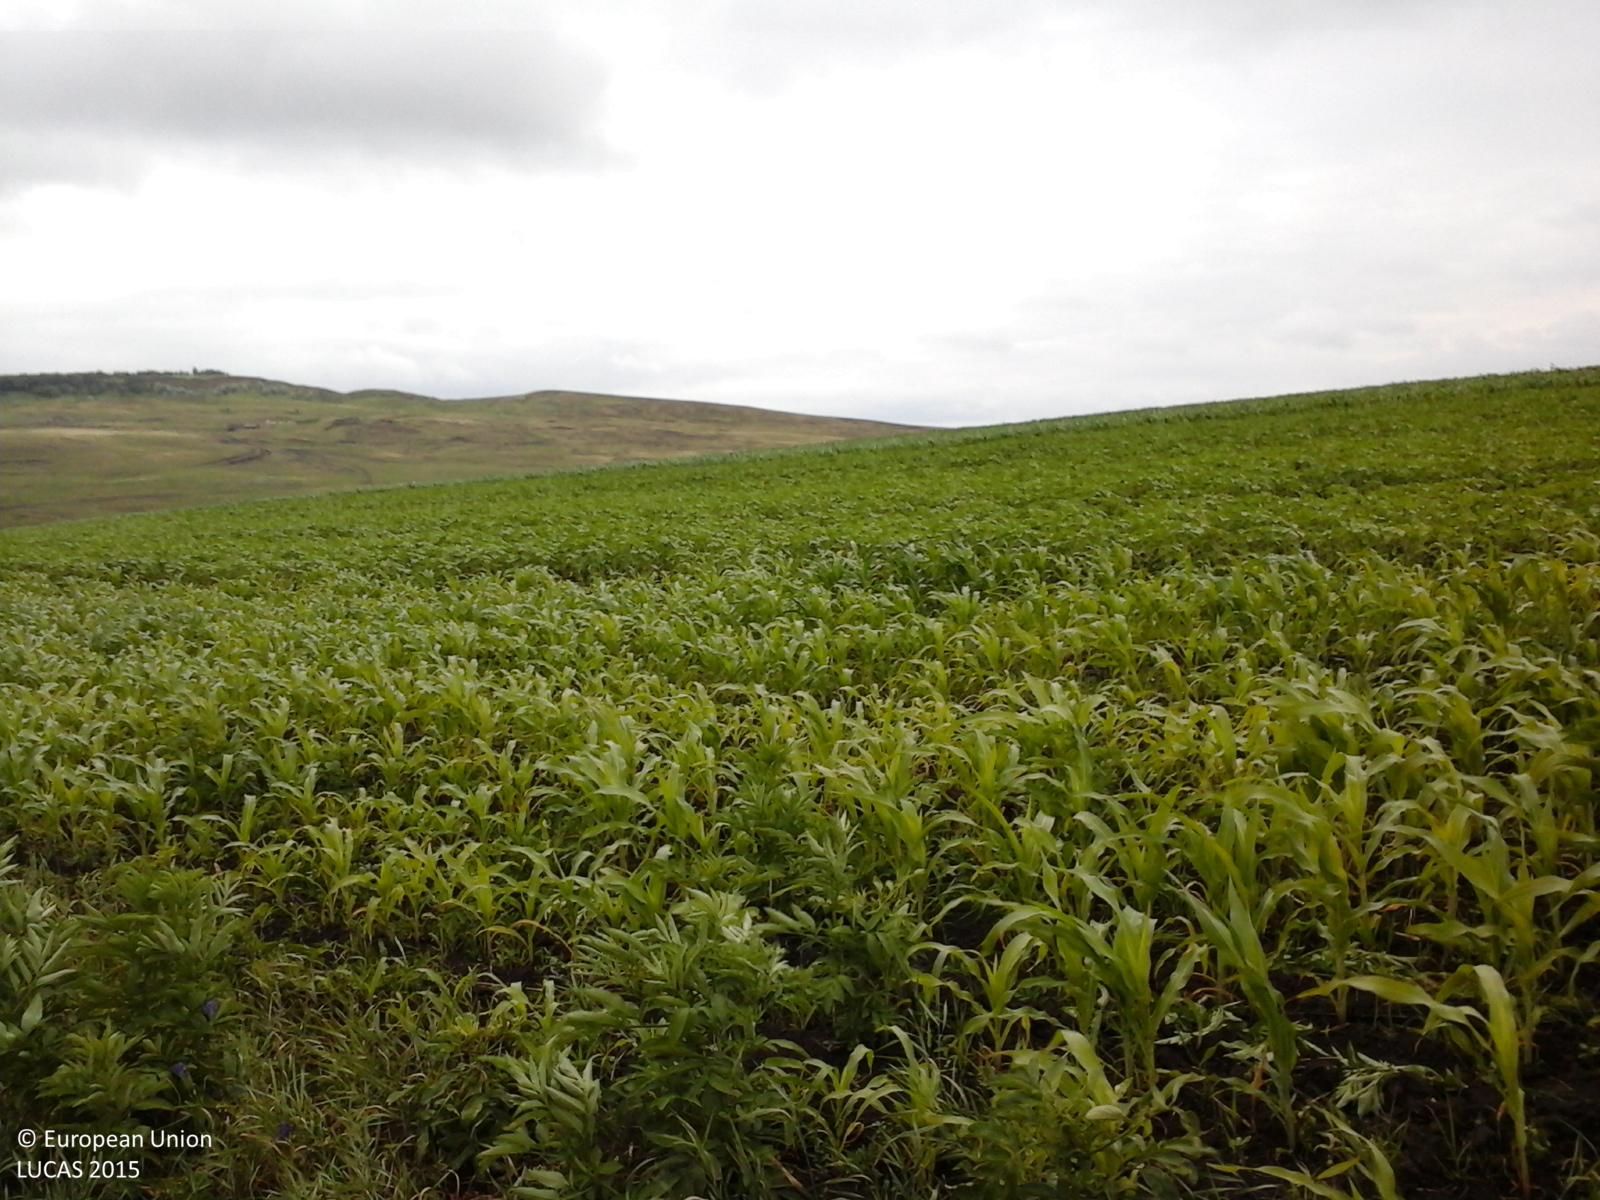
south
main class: Cropland
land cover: Soya
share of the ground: > 75 %
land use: Agriculture (excluding fallow land and kitchen gardens)
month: June
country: RO
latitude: 47.9918
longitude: 26.5354
